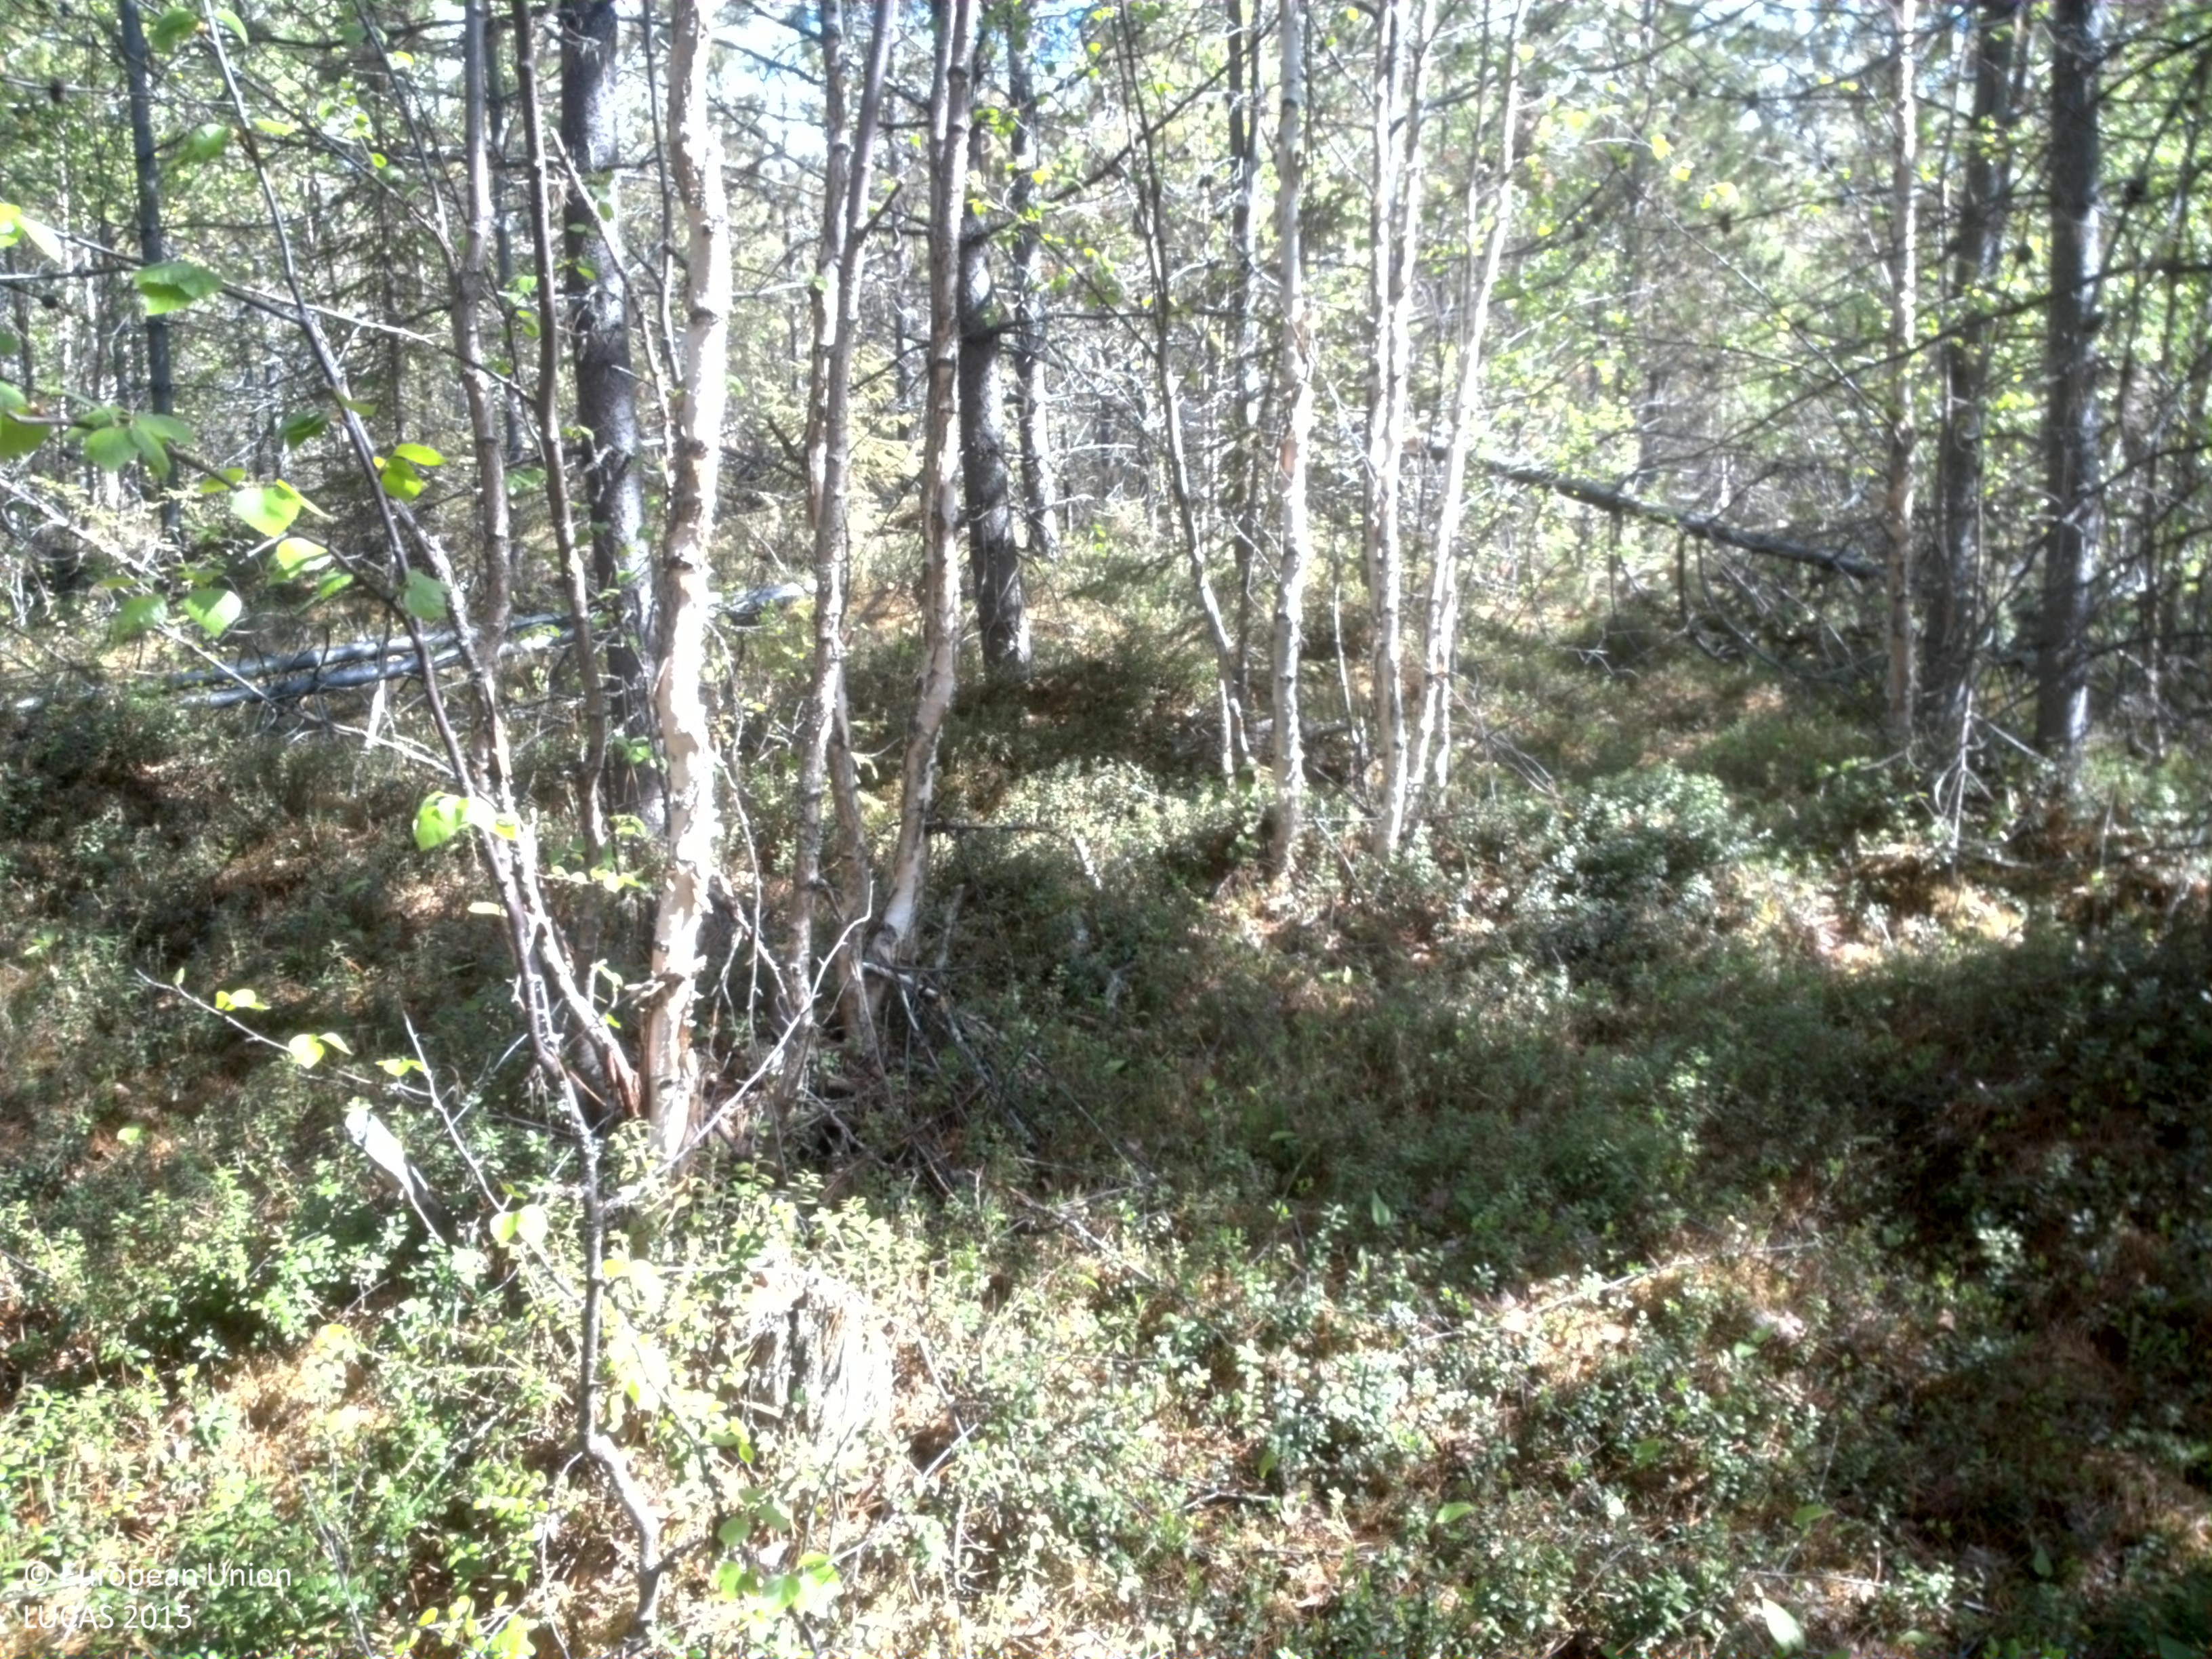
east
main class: Woodland
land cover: Pine dominated mixed woodland
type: boreal forest
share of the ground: 50 - 75 %
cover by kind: coniferous forest trees 40 %, shrubs 35 %, broadleaved forest trees 15 %, lichens and mosses 10 %
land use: Forestry
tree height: > 5 m
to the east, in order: Pine dominated mixed woodland; Spruce dominated coniferous woodland; Pine dominated coniferous woodland
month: June
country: SE
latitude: 66.8821
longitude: 21.8979
